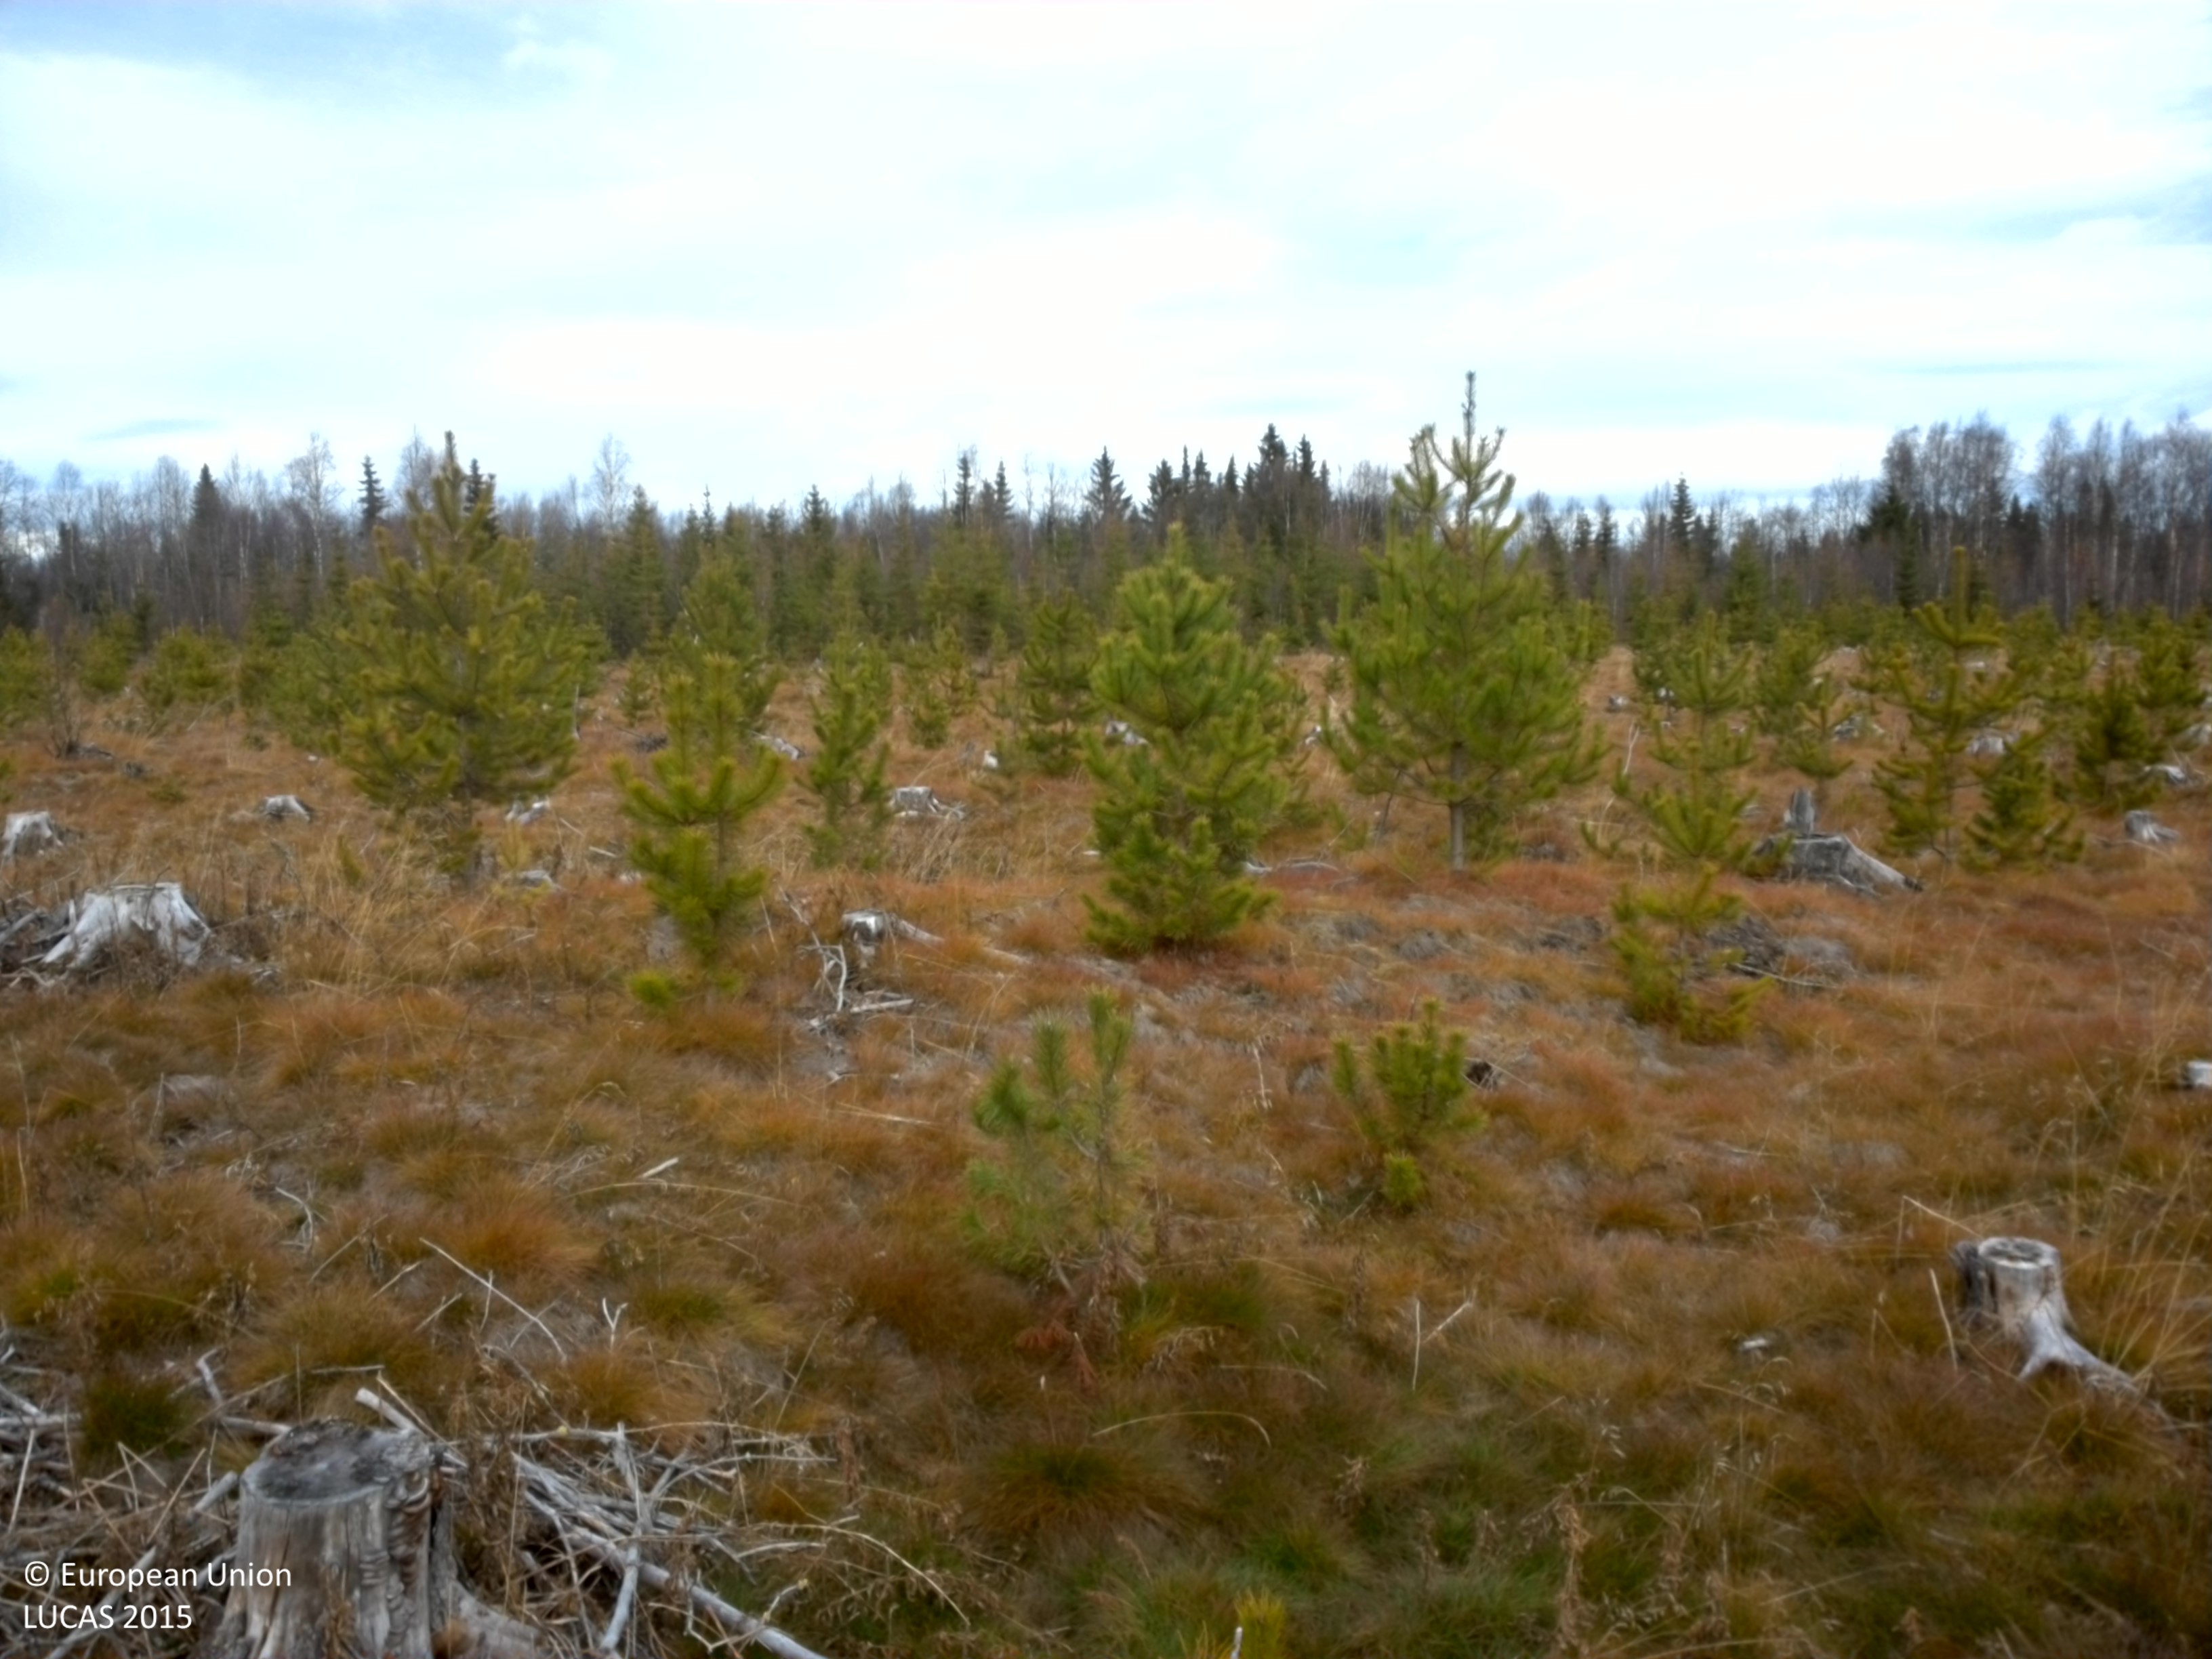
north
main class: Woodland
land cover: Pine dominated coniferous woodland
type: exotic forest
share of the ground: 10 - 25 %
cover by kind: herbaceous plants 85 %, coniferous forest trees 10 %, lichens and mosses 5 %
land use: Forestry
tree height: < 5 m
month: October
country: SE
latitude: 64.5764
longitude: 16.4184
